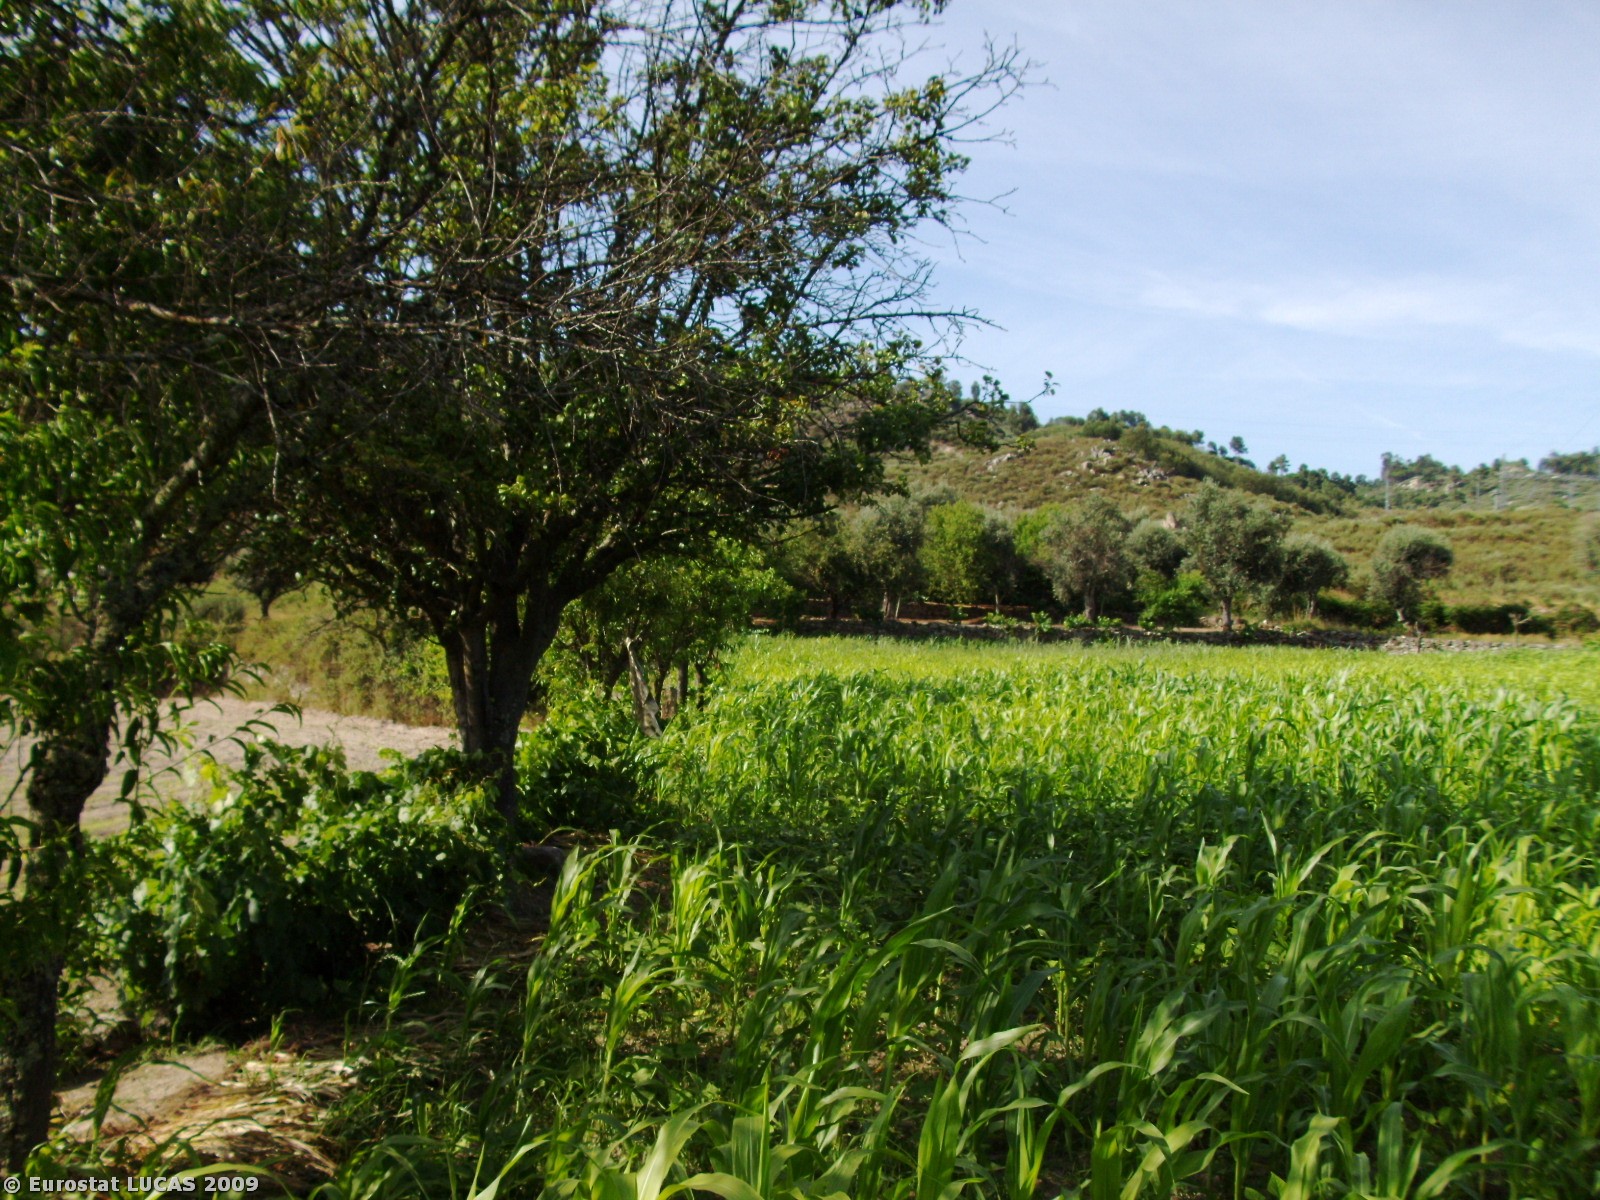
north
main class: Cropland
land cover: Maize
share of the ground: > 75 %
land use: Agriculture (excluding fallow land and kitchen gardens)
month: July
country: PT
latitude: 40.5715
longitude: -7.6575
